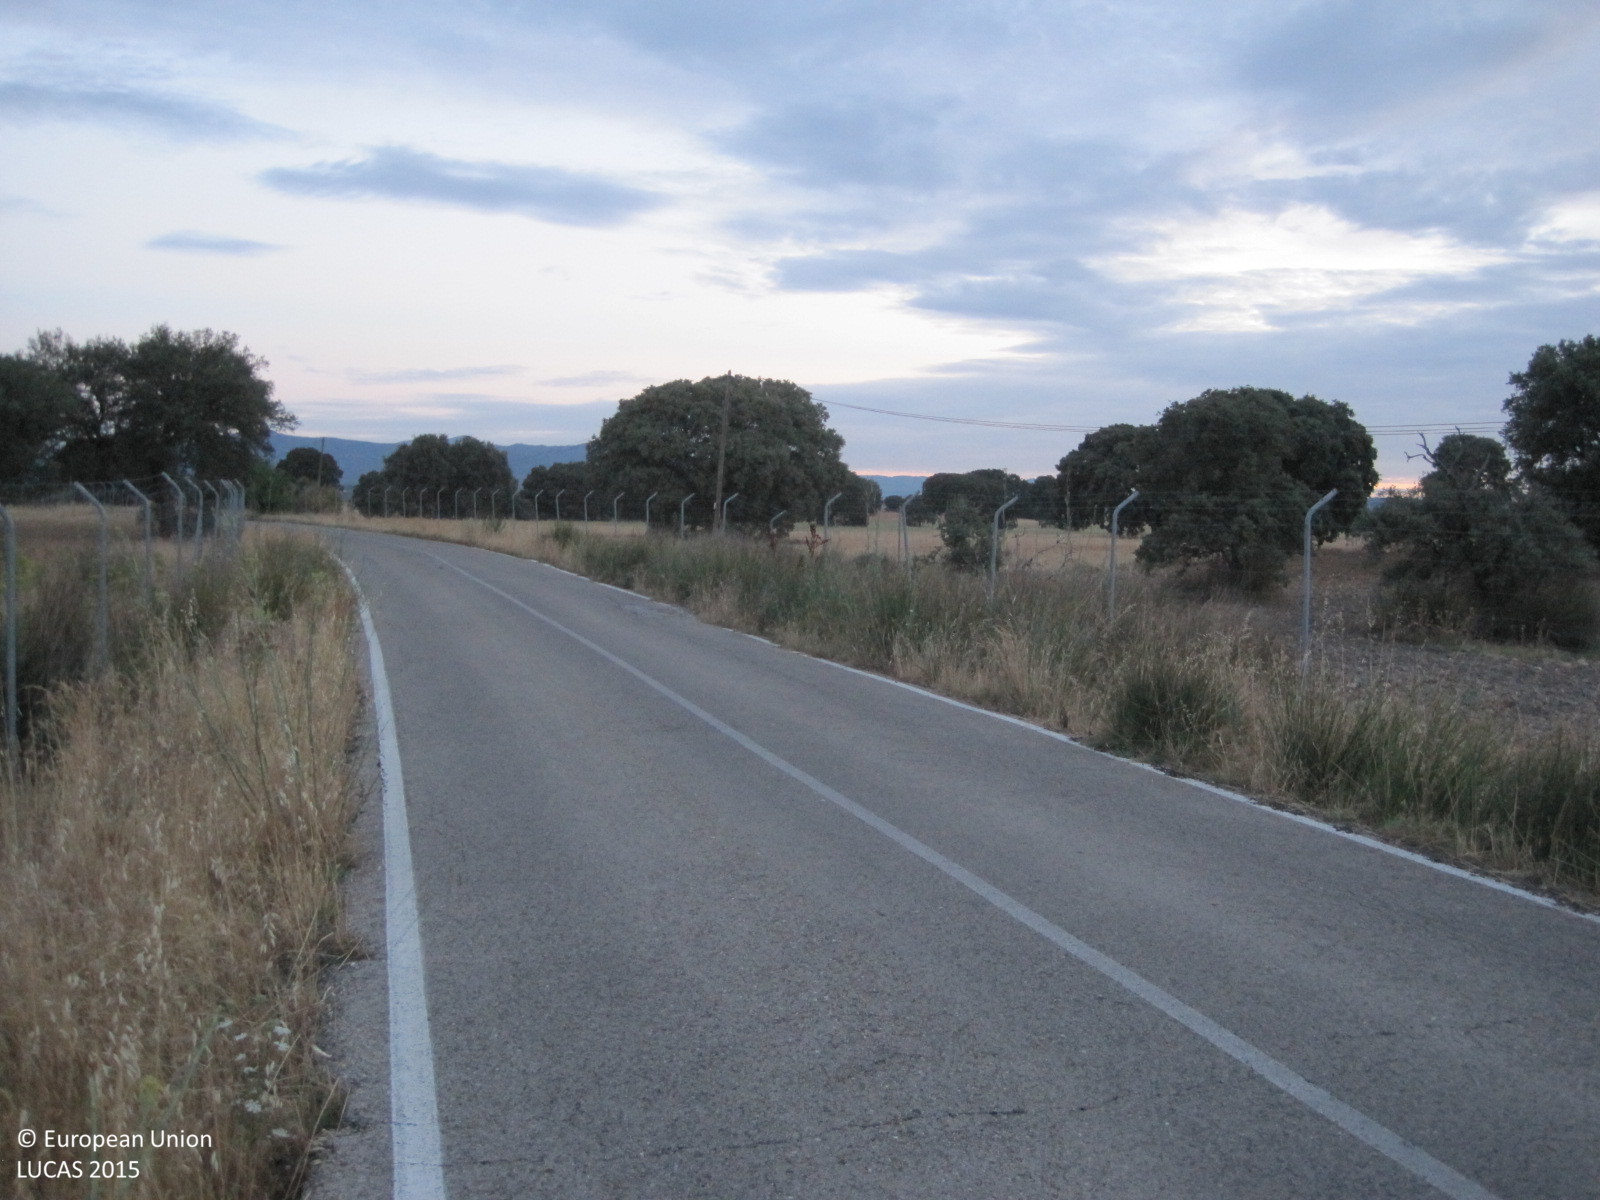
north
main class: Grassland
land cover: Spontaneously vegetated surfaces
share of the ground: > 75 %
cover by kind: herbaceous plants 100 %
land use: Agriculture (excluding fallow land and kitchen gardens)
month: July
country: ES
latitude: 40.1914
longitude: -4.3862
